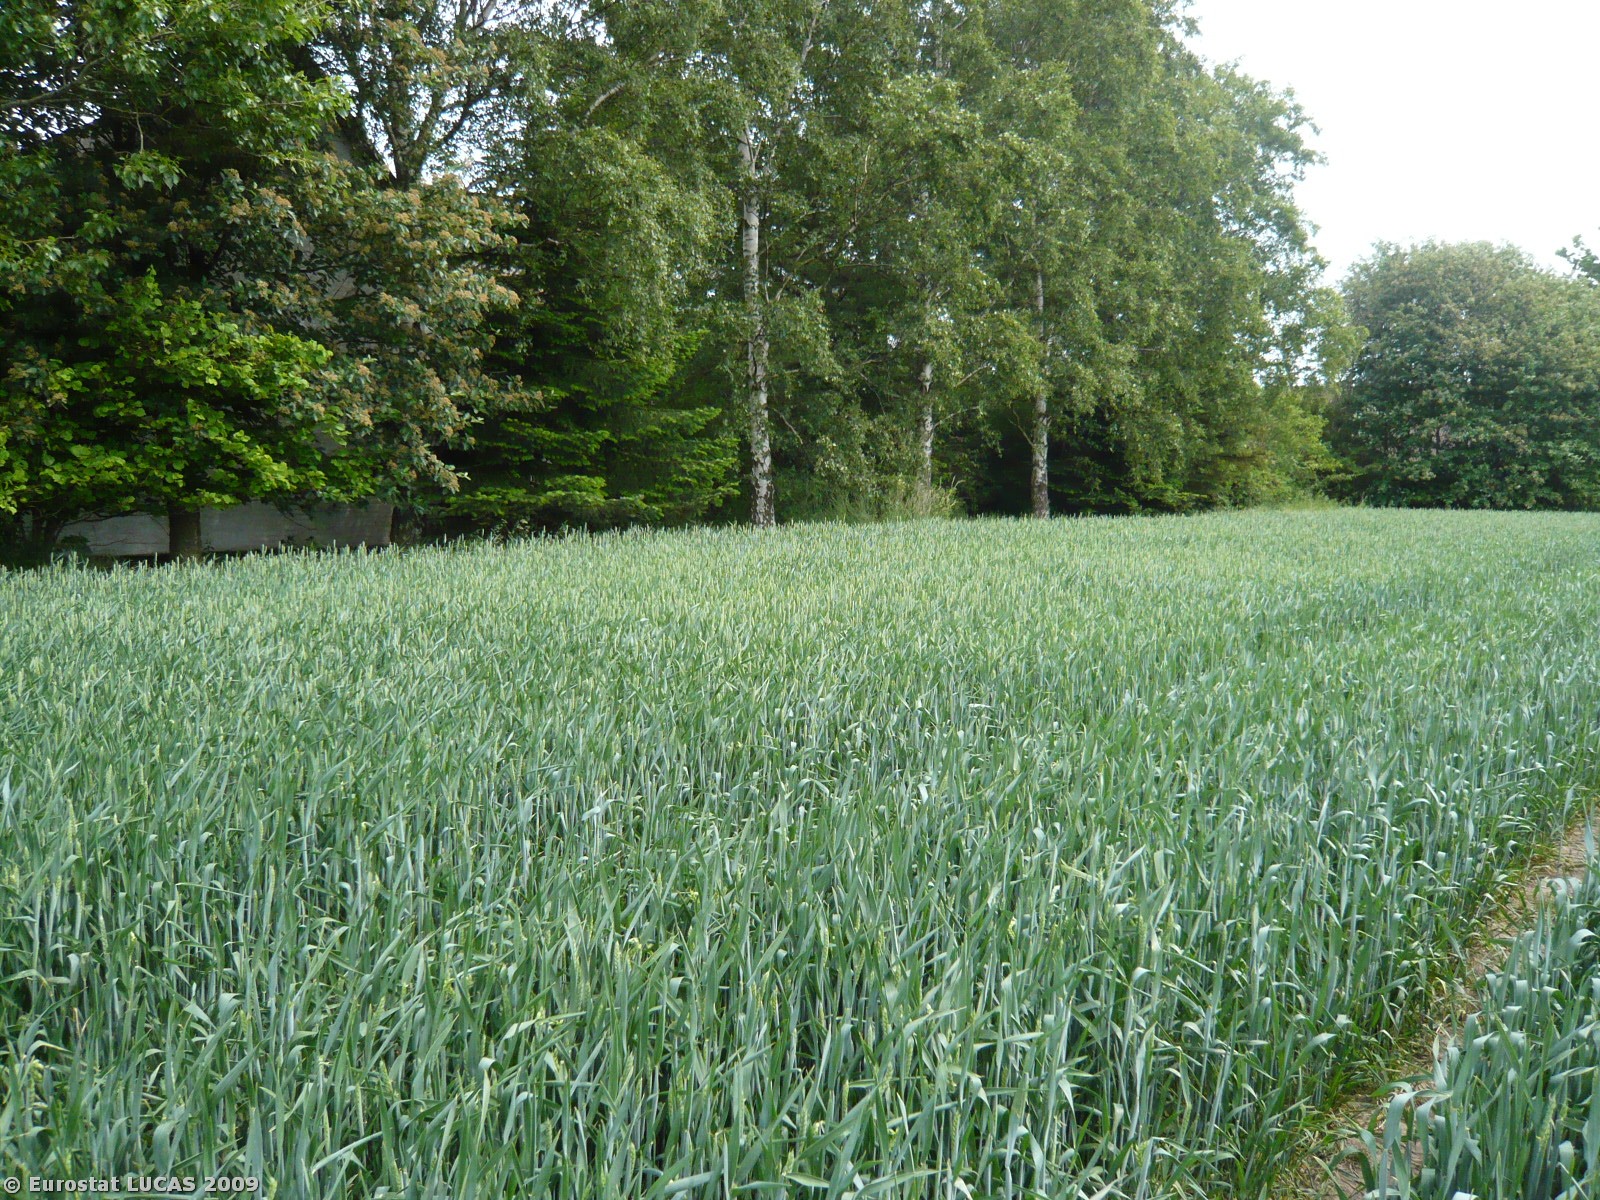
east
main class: Cropland
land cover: Common wheat
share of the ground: > 75 %
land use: Agriculture (excluding fallow land and kitchen gardens)
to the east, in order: Common wheat; Broadleaved woodland; Artificial constructions in urban areas; Broadleaved woodland
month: June
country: DK
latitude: 55.2816
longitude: 11.3686
